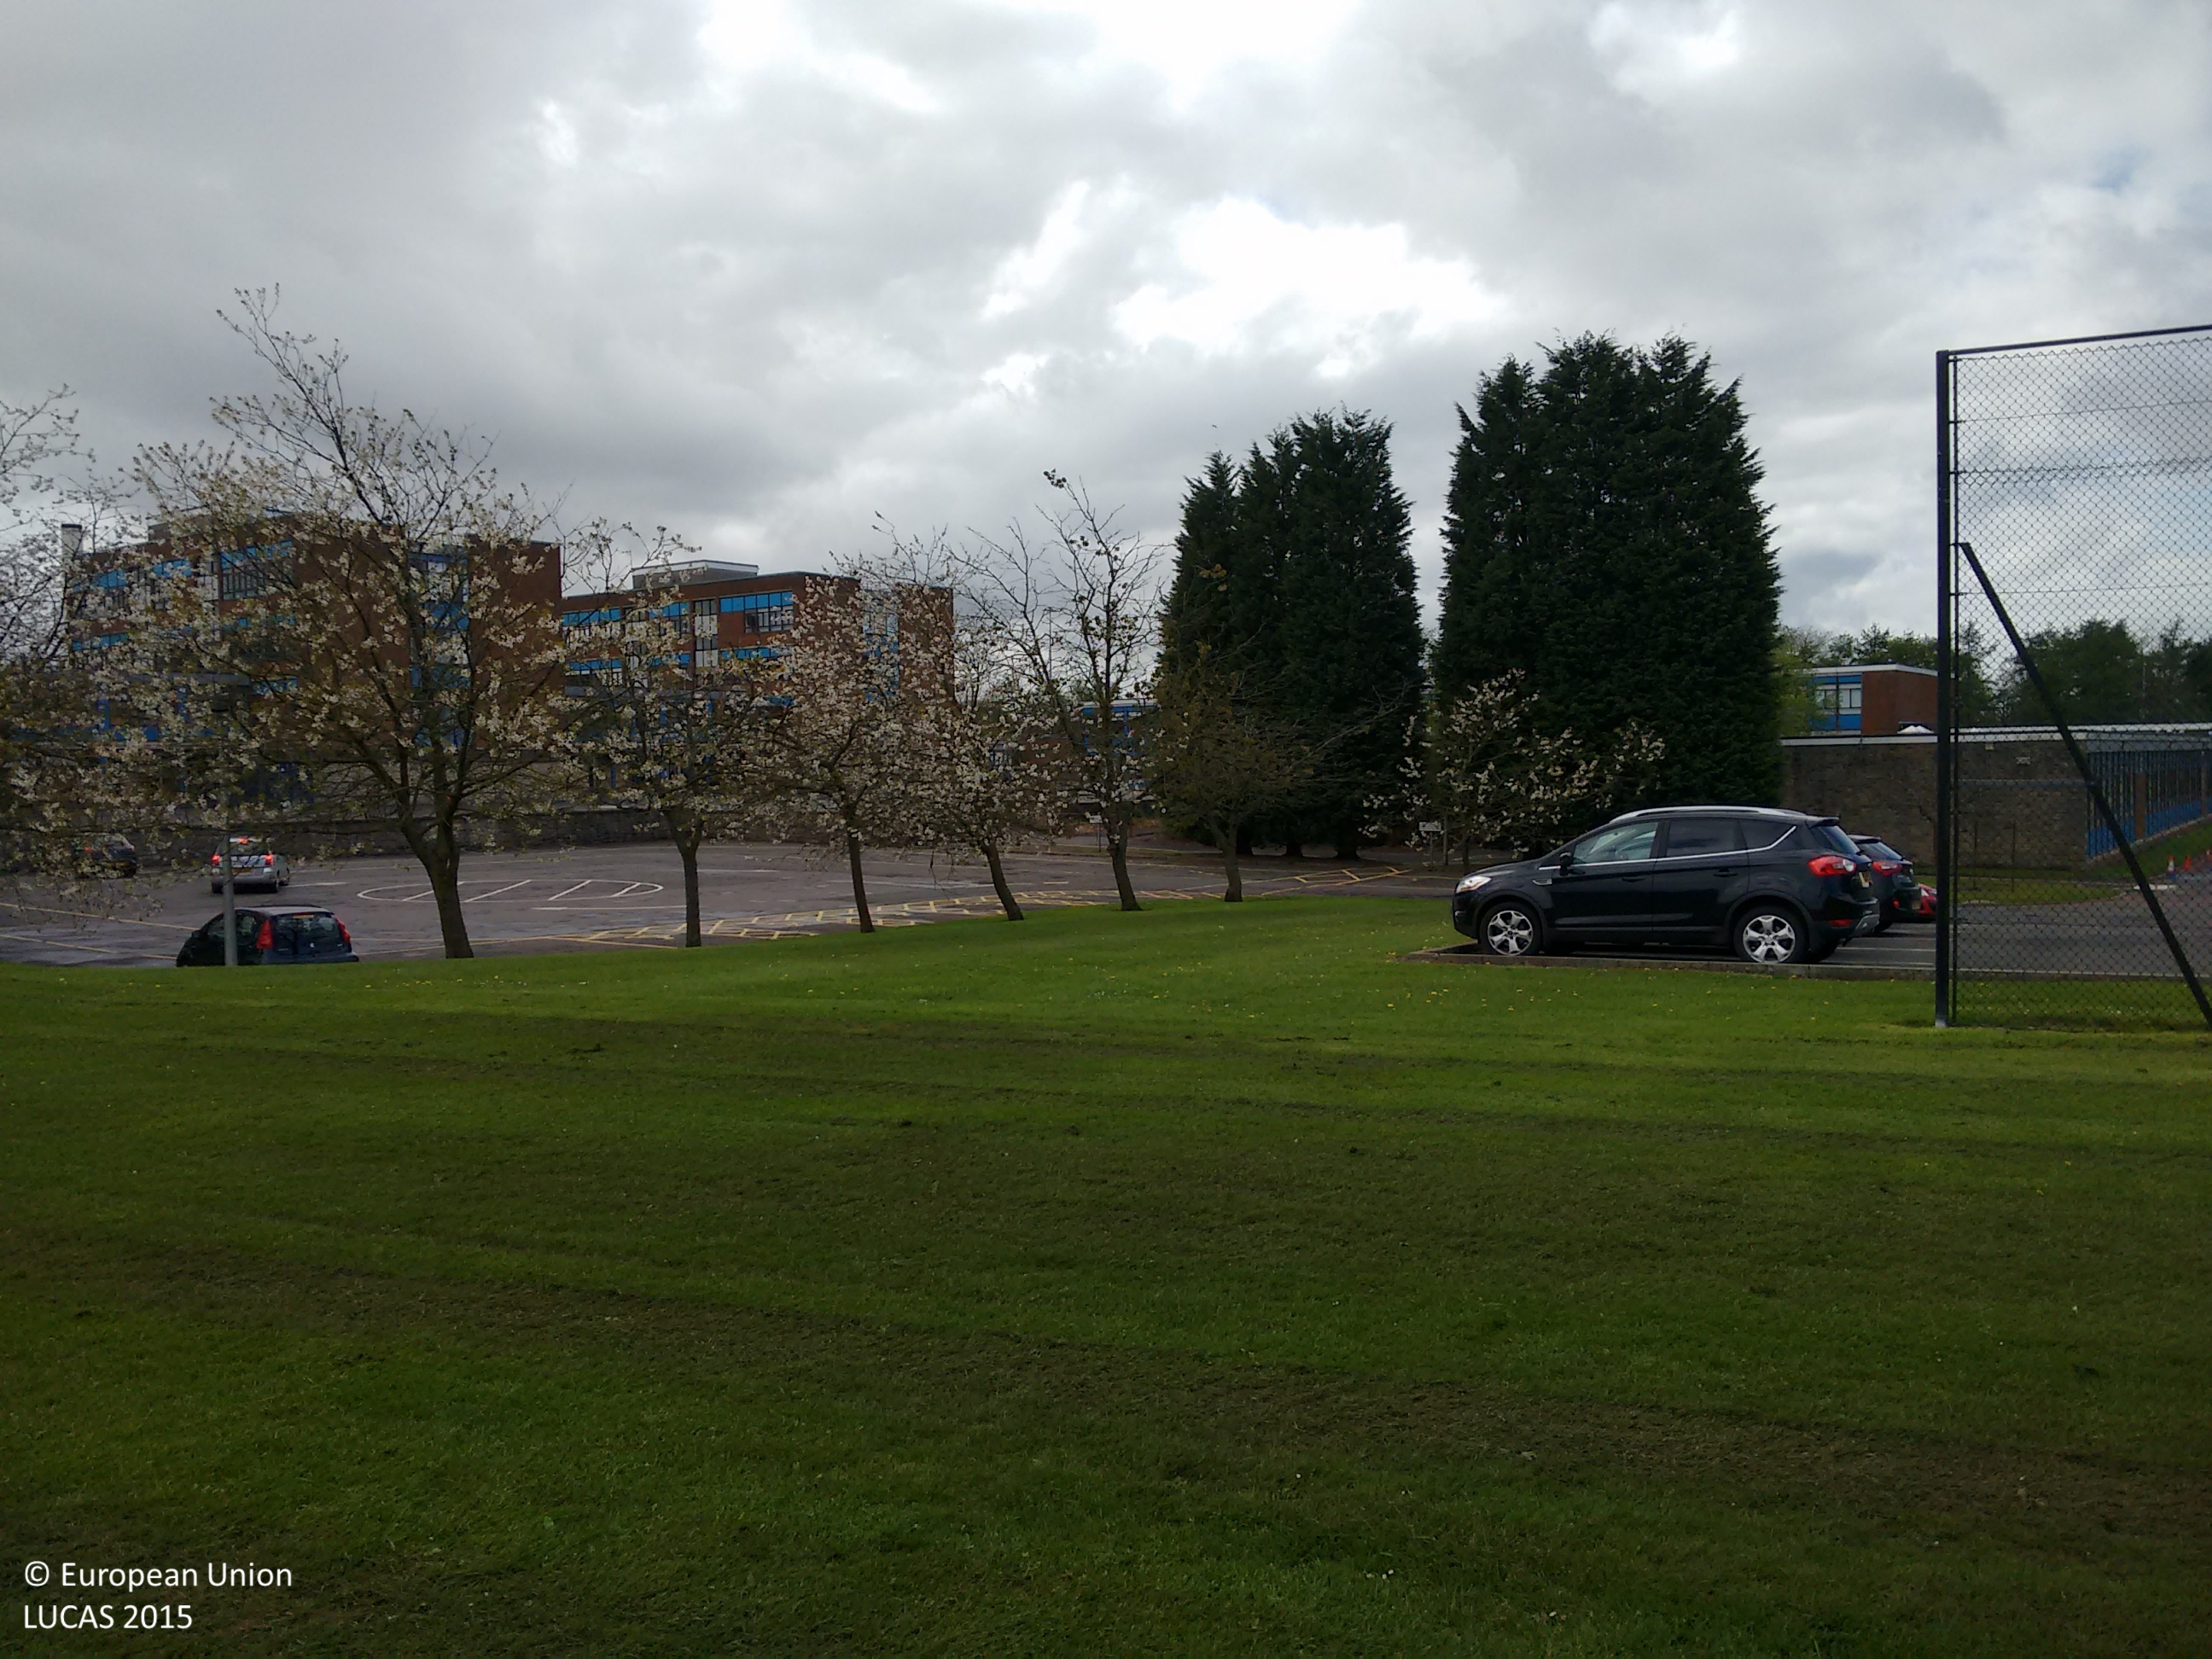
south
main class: Grassland
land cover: Grassland without tree/shrub cover
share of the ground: > 75 %
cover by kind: herbaceous plants 100 %
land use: Sport
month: May
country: GB
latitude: 55.9484
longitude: -3.9705
